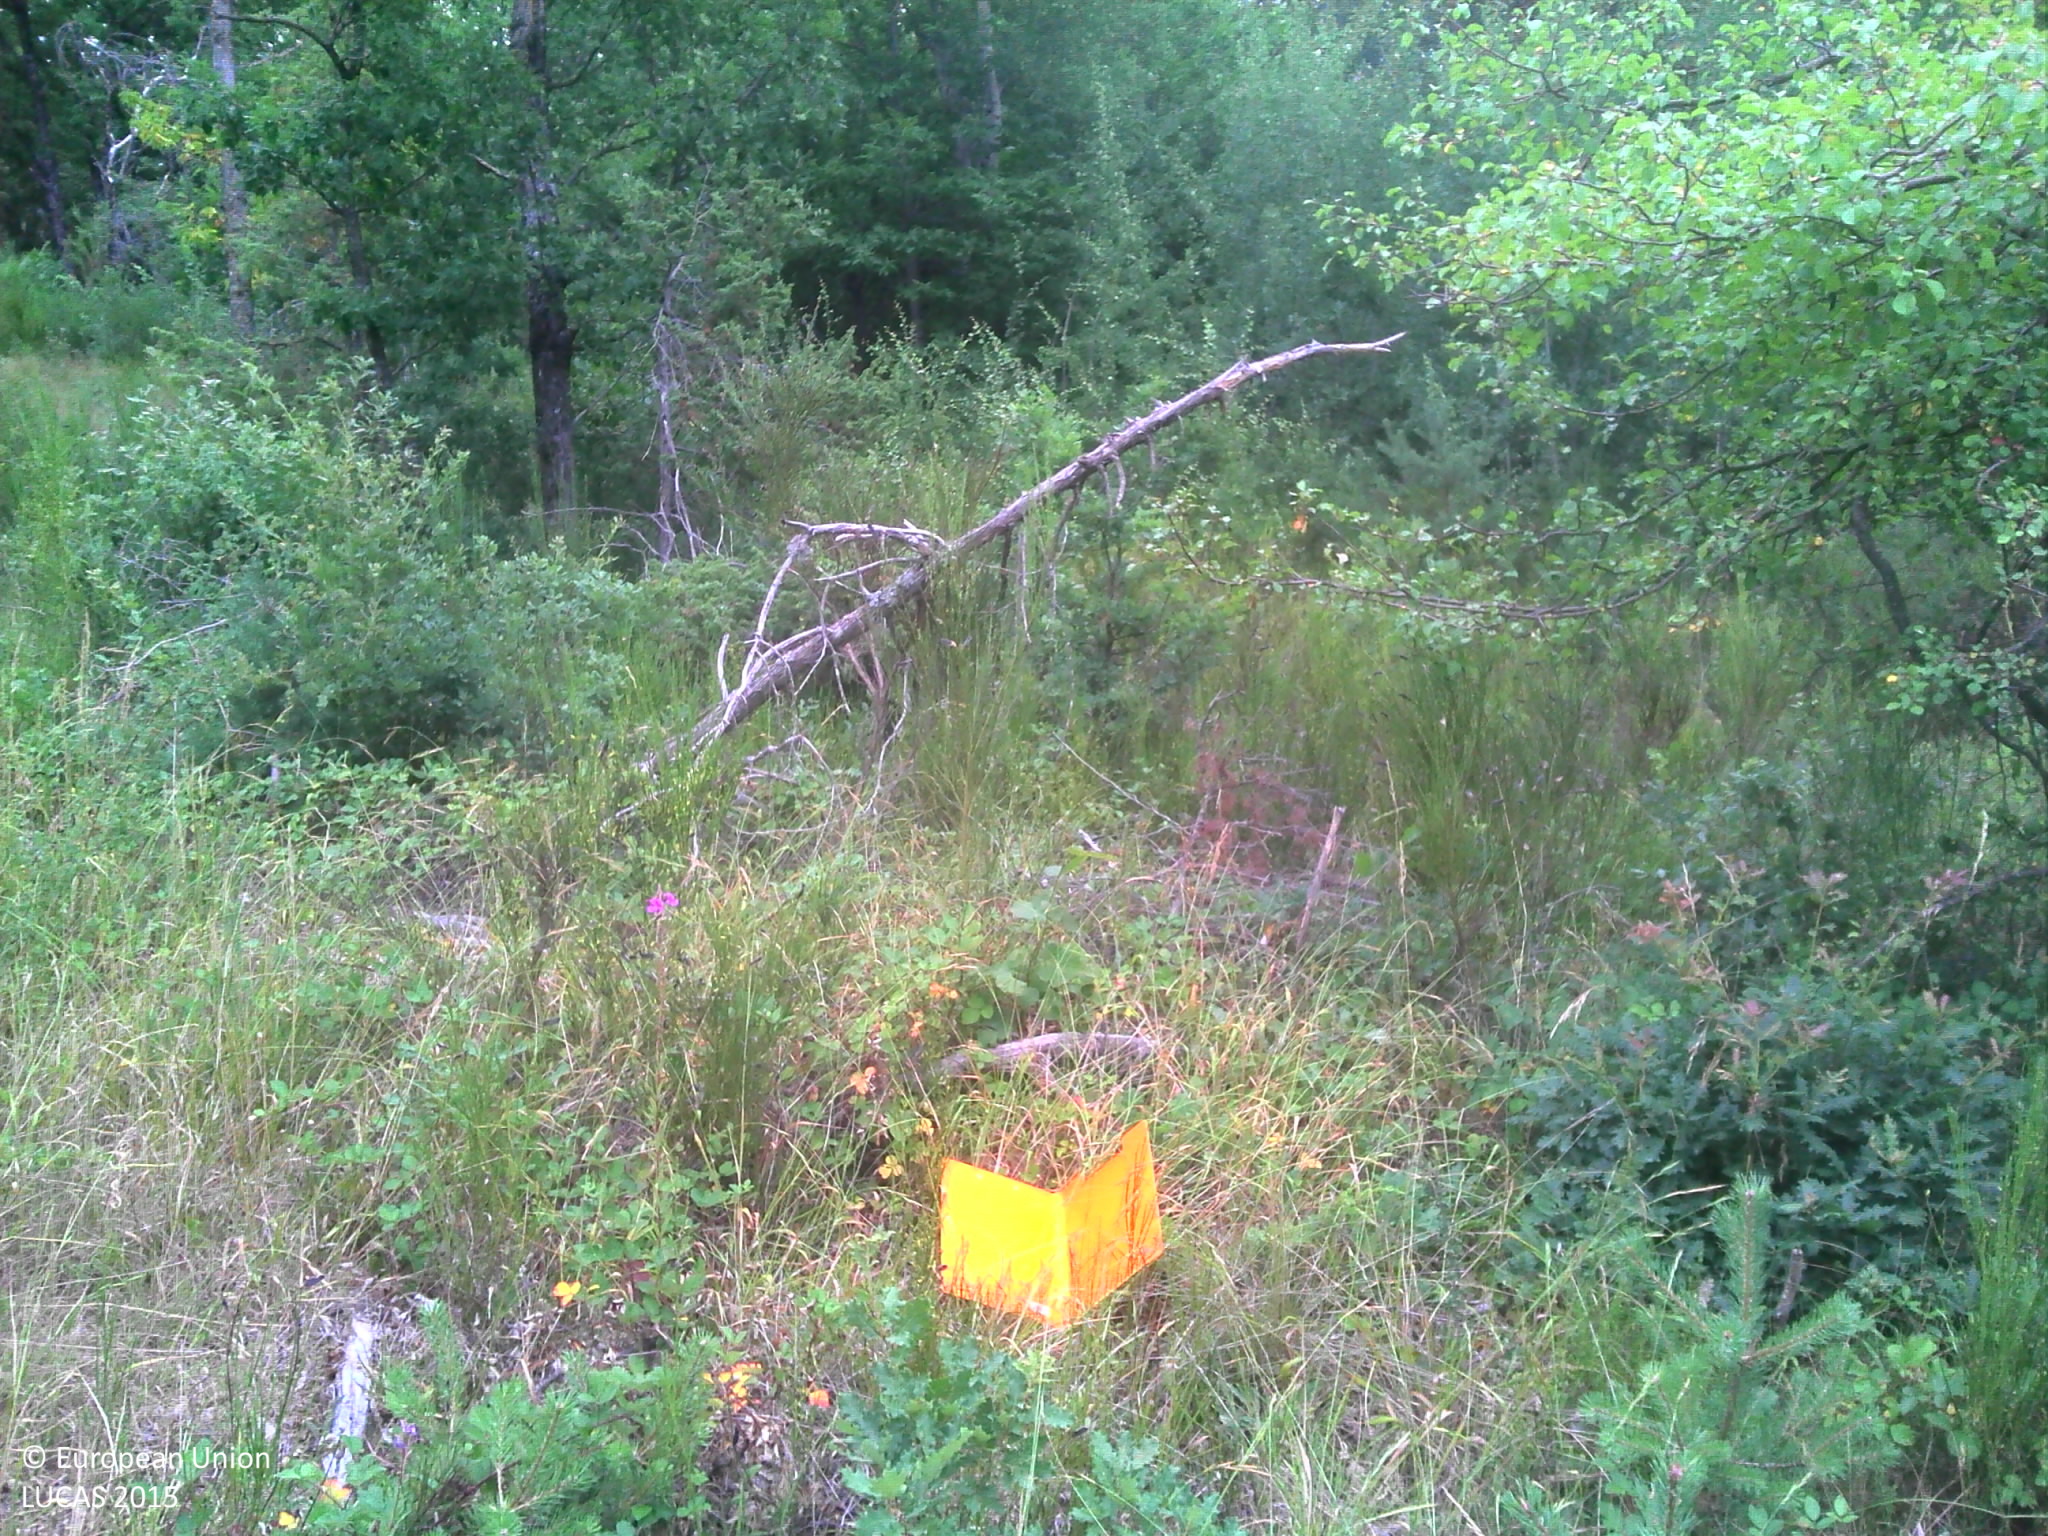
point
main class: Woodland
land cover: Broadleaved woodland
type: thermophilous deciduous forest
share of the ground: 25 - 50 %
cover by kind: broadleaved forest trees 40 %, herbaceous plants 35 %, shrubs 20 %, consolidated bare surface 5 %
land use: Forestry
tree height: > 5 m
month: July
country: FR
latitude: 44.1105
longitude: 5.5476
